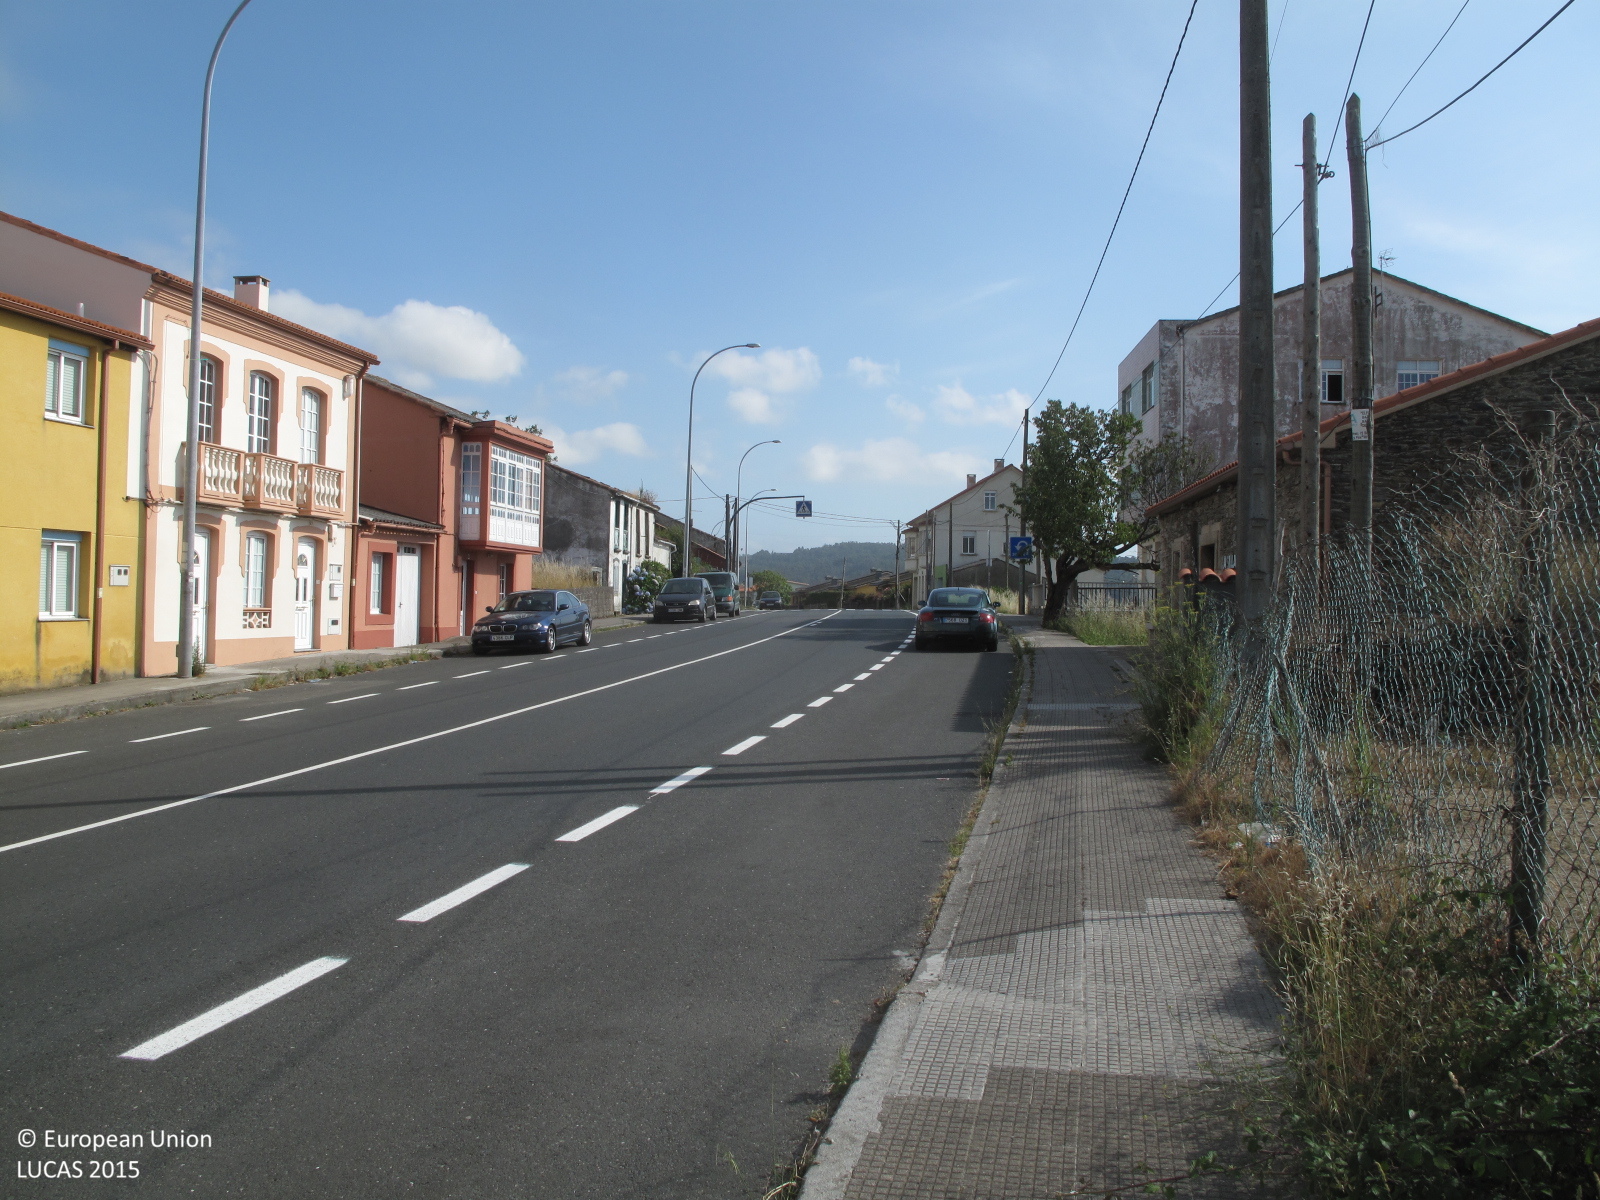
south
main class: Woodland
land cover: Broadleaved woodland
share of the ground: > 75 %
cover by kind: broadleaved forest trees 90 %, herbaceous plants 10 %
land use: Residential
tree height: > 5 m
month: July
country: ES
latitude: 43.4871
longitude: -8.1660
